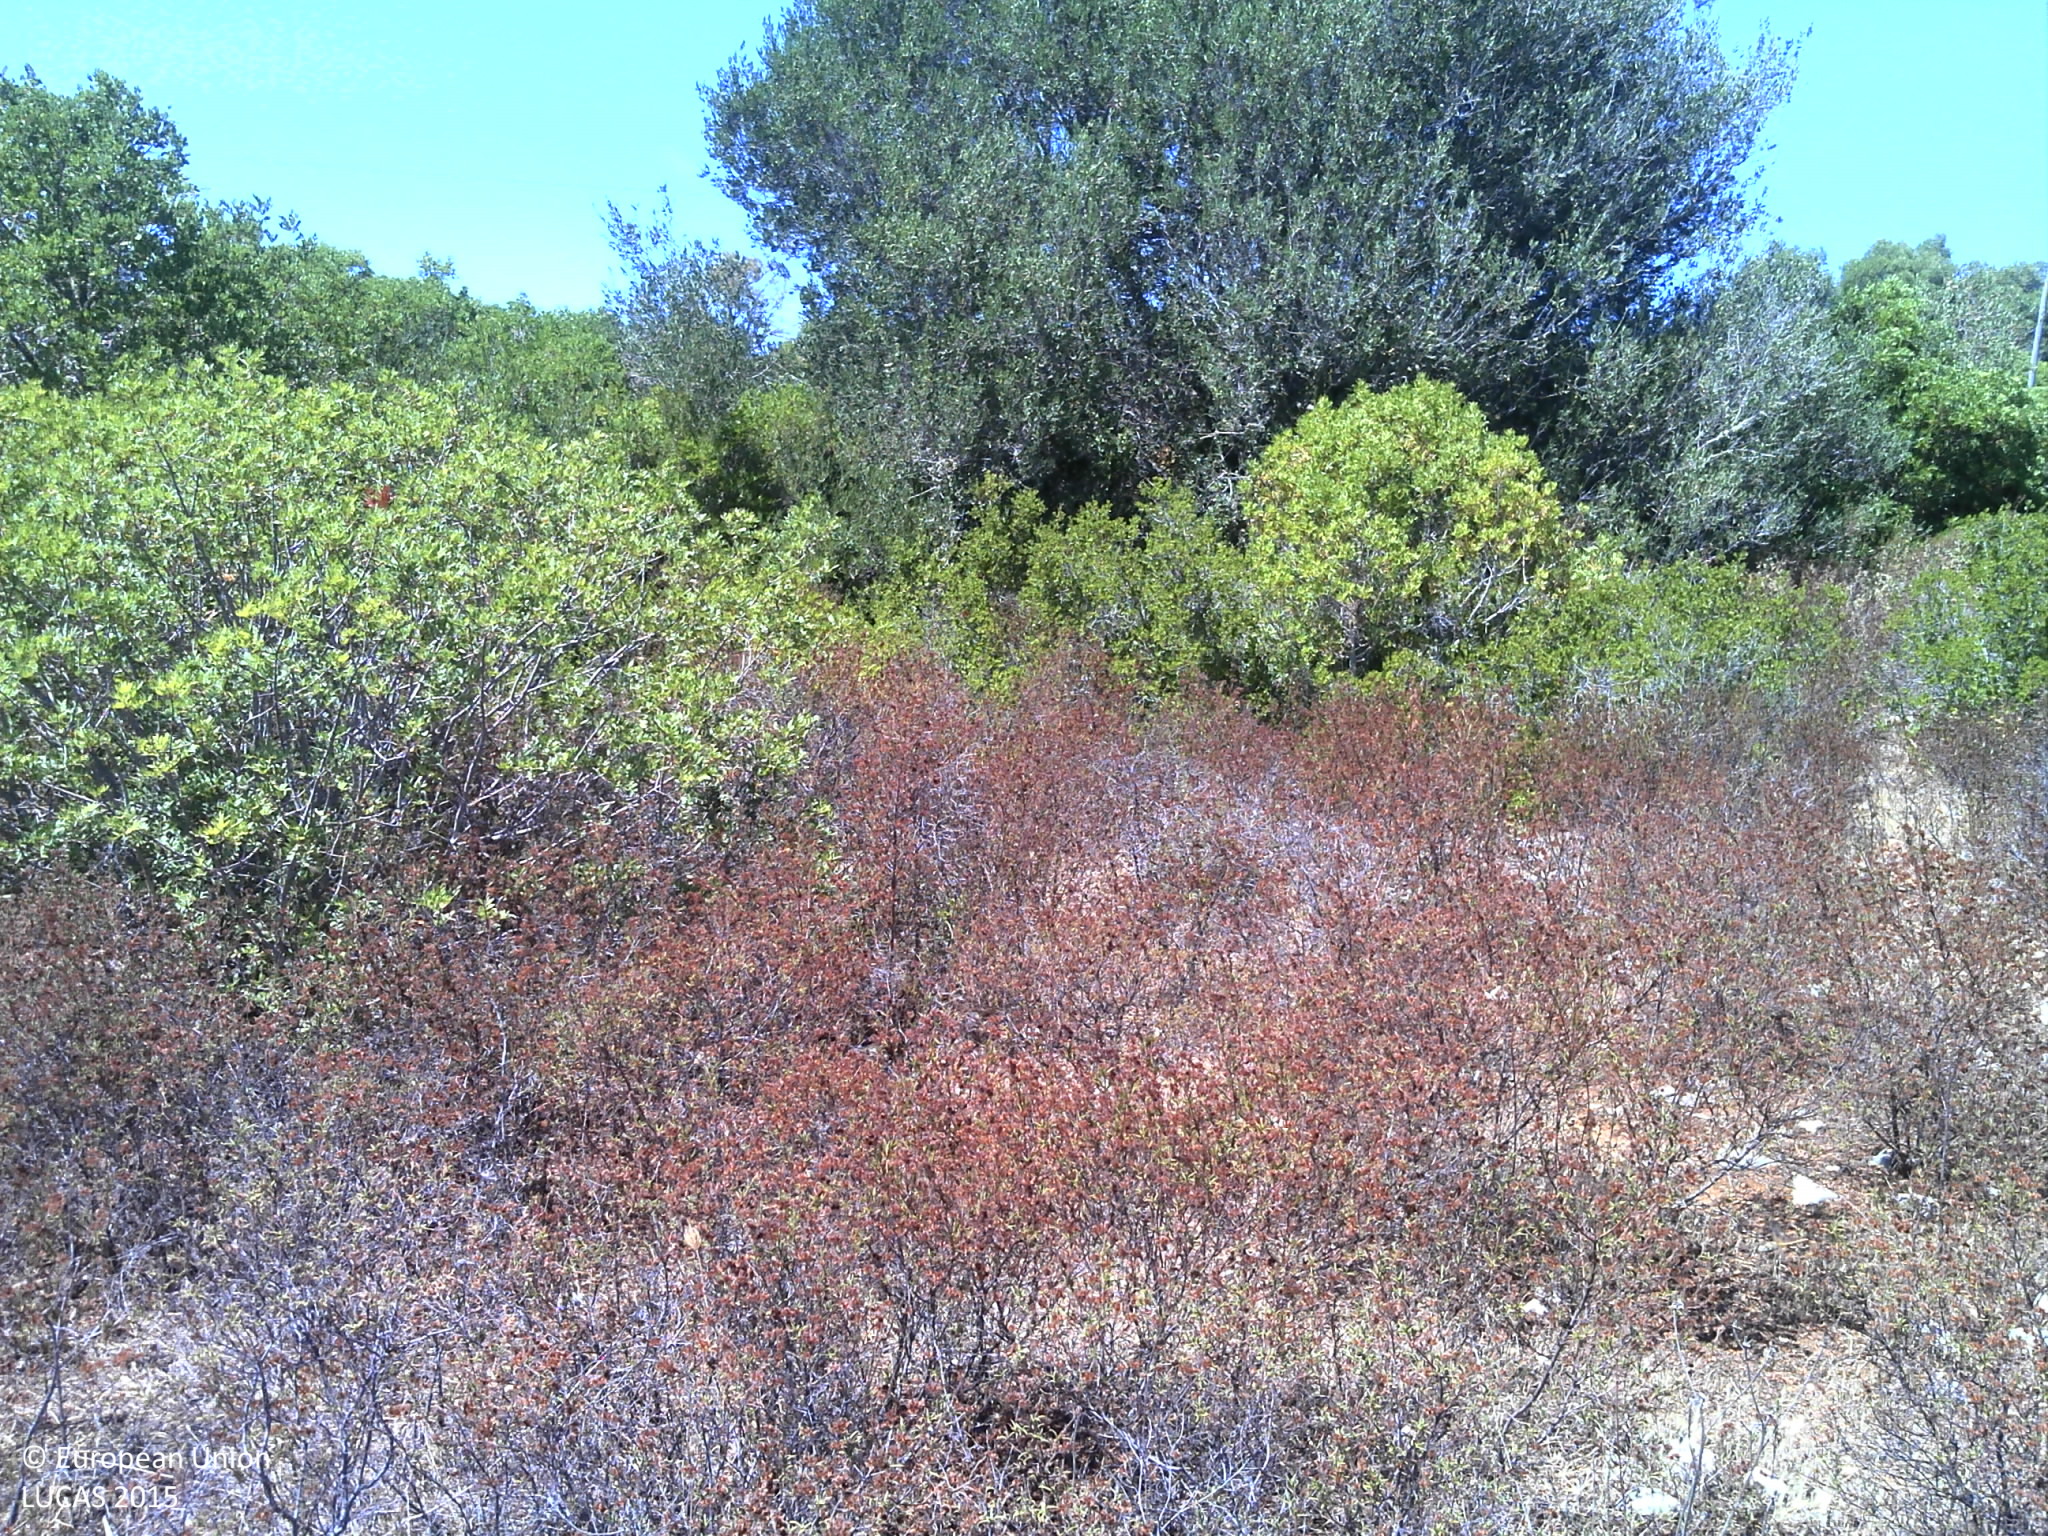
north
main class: Grassland
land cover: Grassland with sparse tree/shrub cover
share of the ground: 50 - 75 %
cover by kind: herbaceous plants 60 %, unconsolidated bare surface 30 %, broadleaved forest trees 5 %, shrubs 5 %
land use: Agriculture (excluding fallow land and kitchen gardens)
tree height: < 5 m
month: July
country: PT
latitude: 37.1260
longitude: -8.7485
